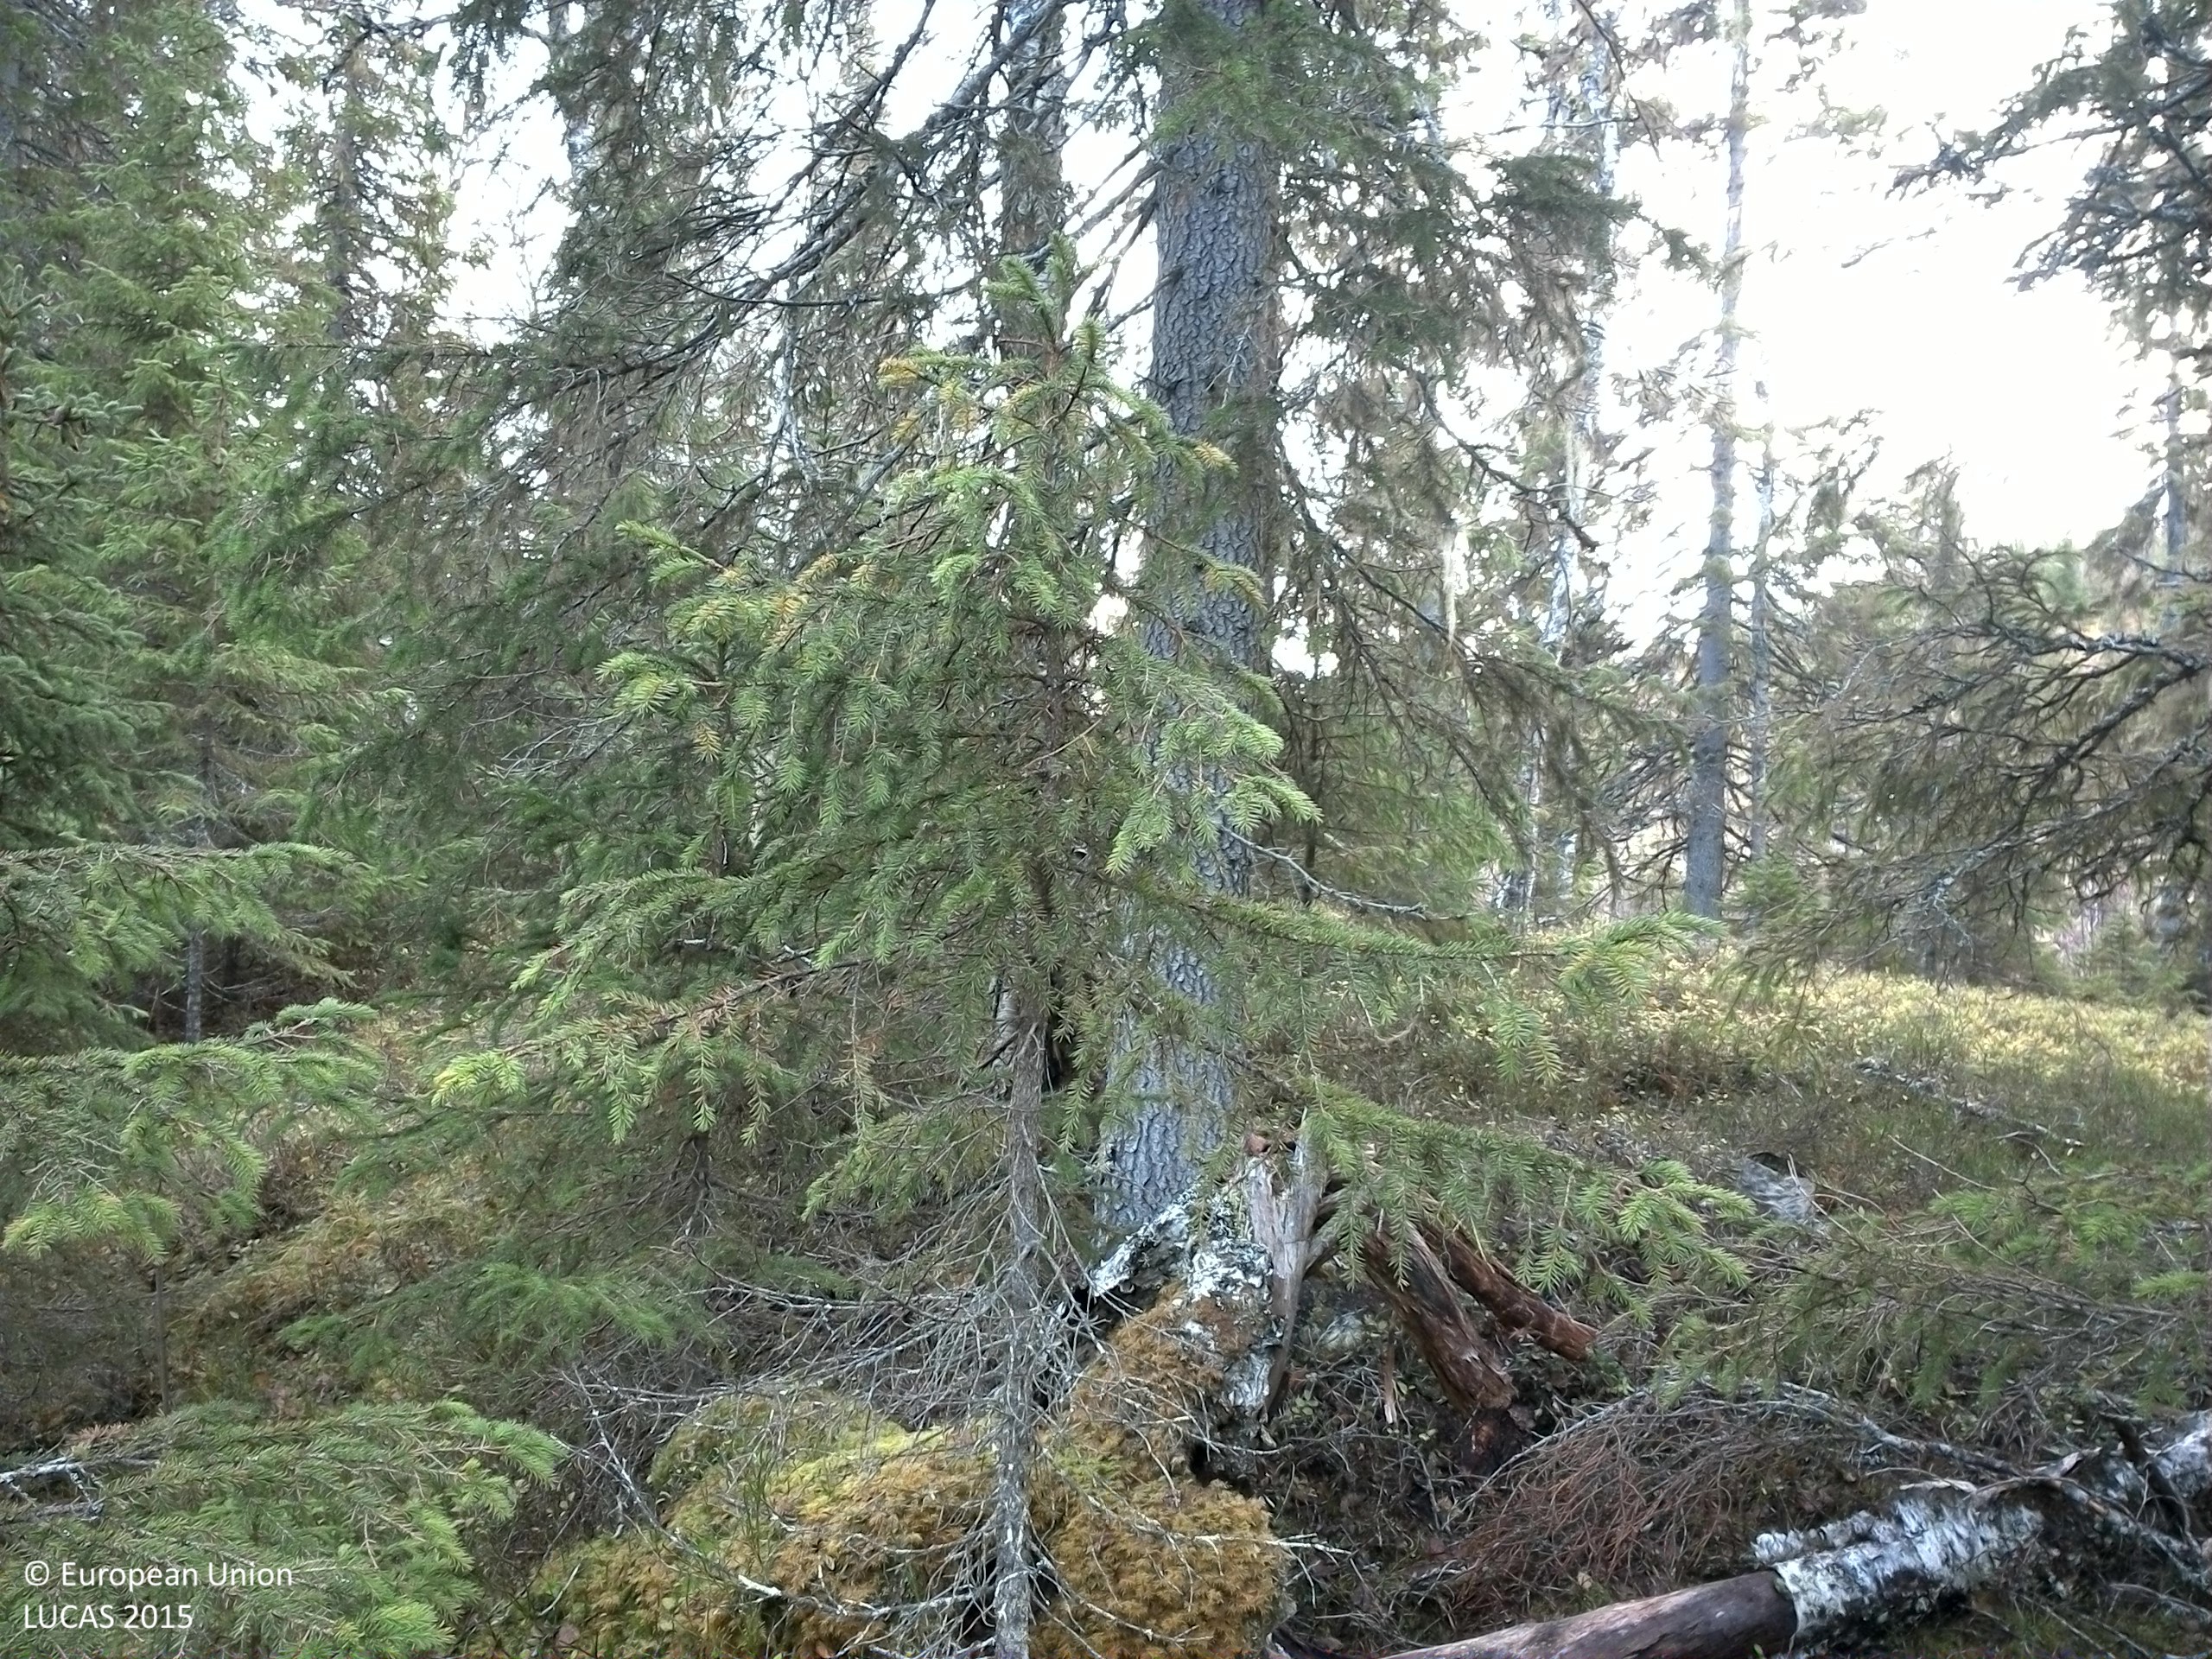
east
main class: Woodland
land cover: Spruce dominated coniferous woodland
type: boreal forest
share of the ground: 25 - 50 %
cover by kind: coniferous forest trees 40 %, shrubs 40 %, lichens and mosses 15 %, broadleaved forest trees 5 %
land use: Forestry
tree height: > 5 m
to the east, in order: Spruce dominated coniferous woodland; Spruce dominated mixed woodland; Peatbogs; Spruce dominated mixed woodland
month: October
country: SE
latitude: 64.6196
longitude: 13.9694
